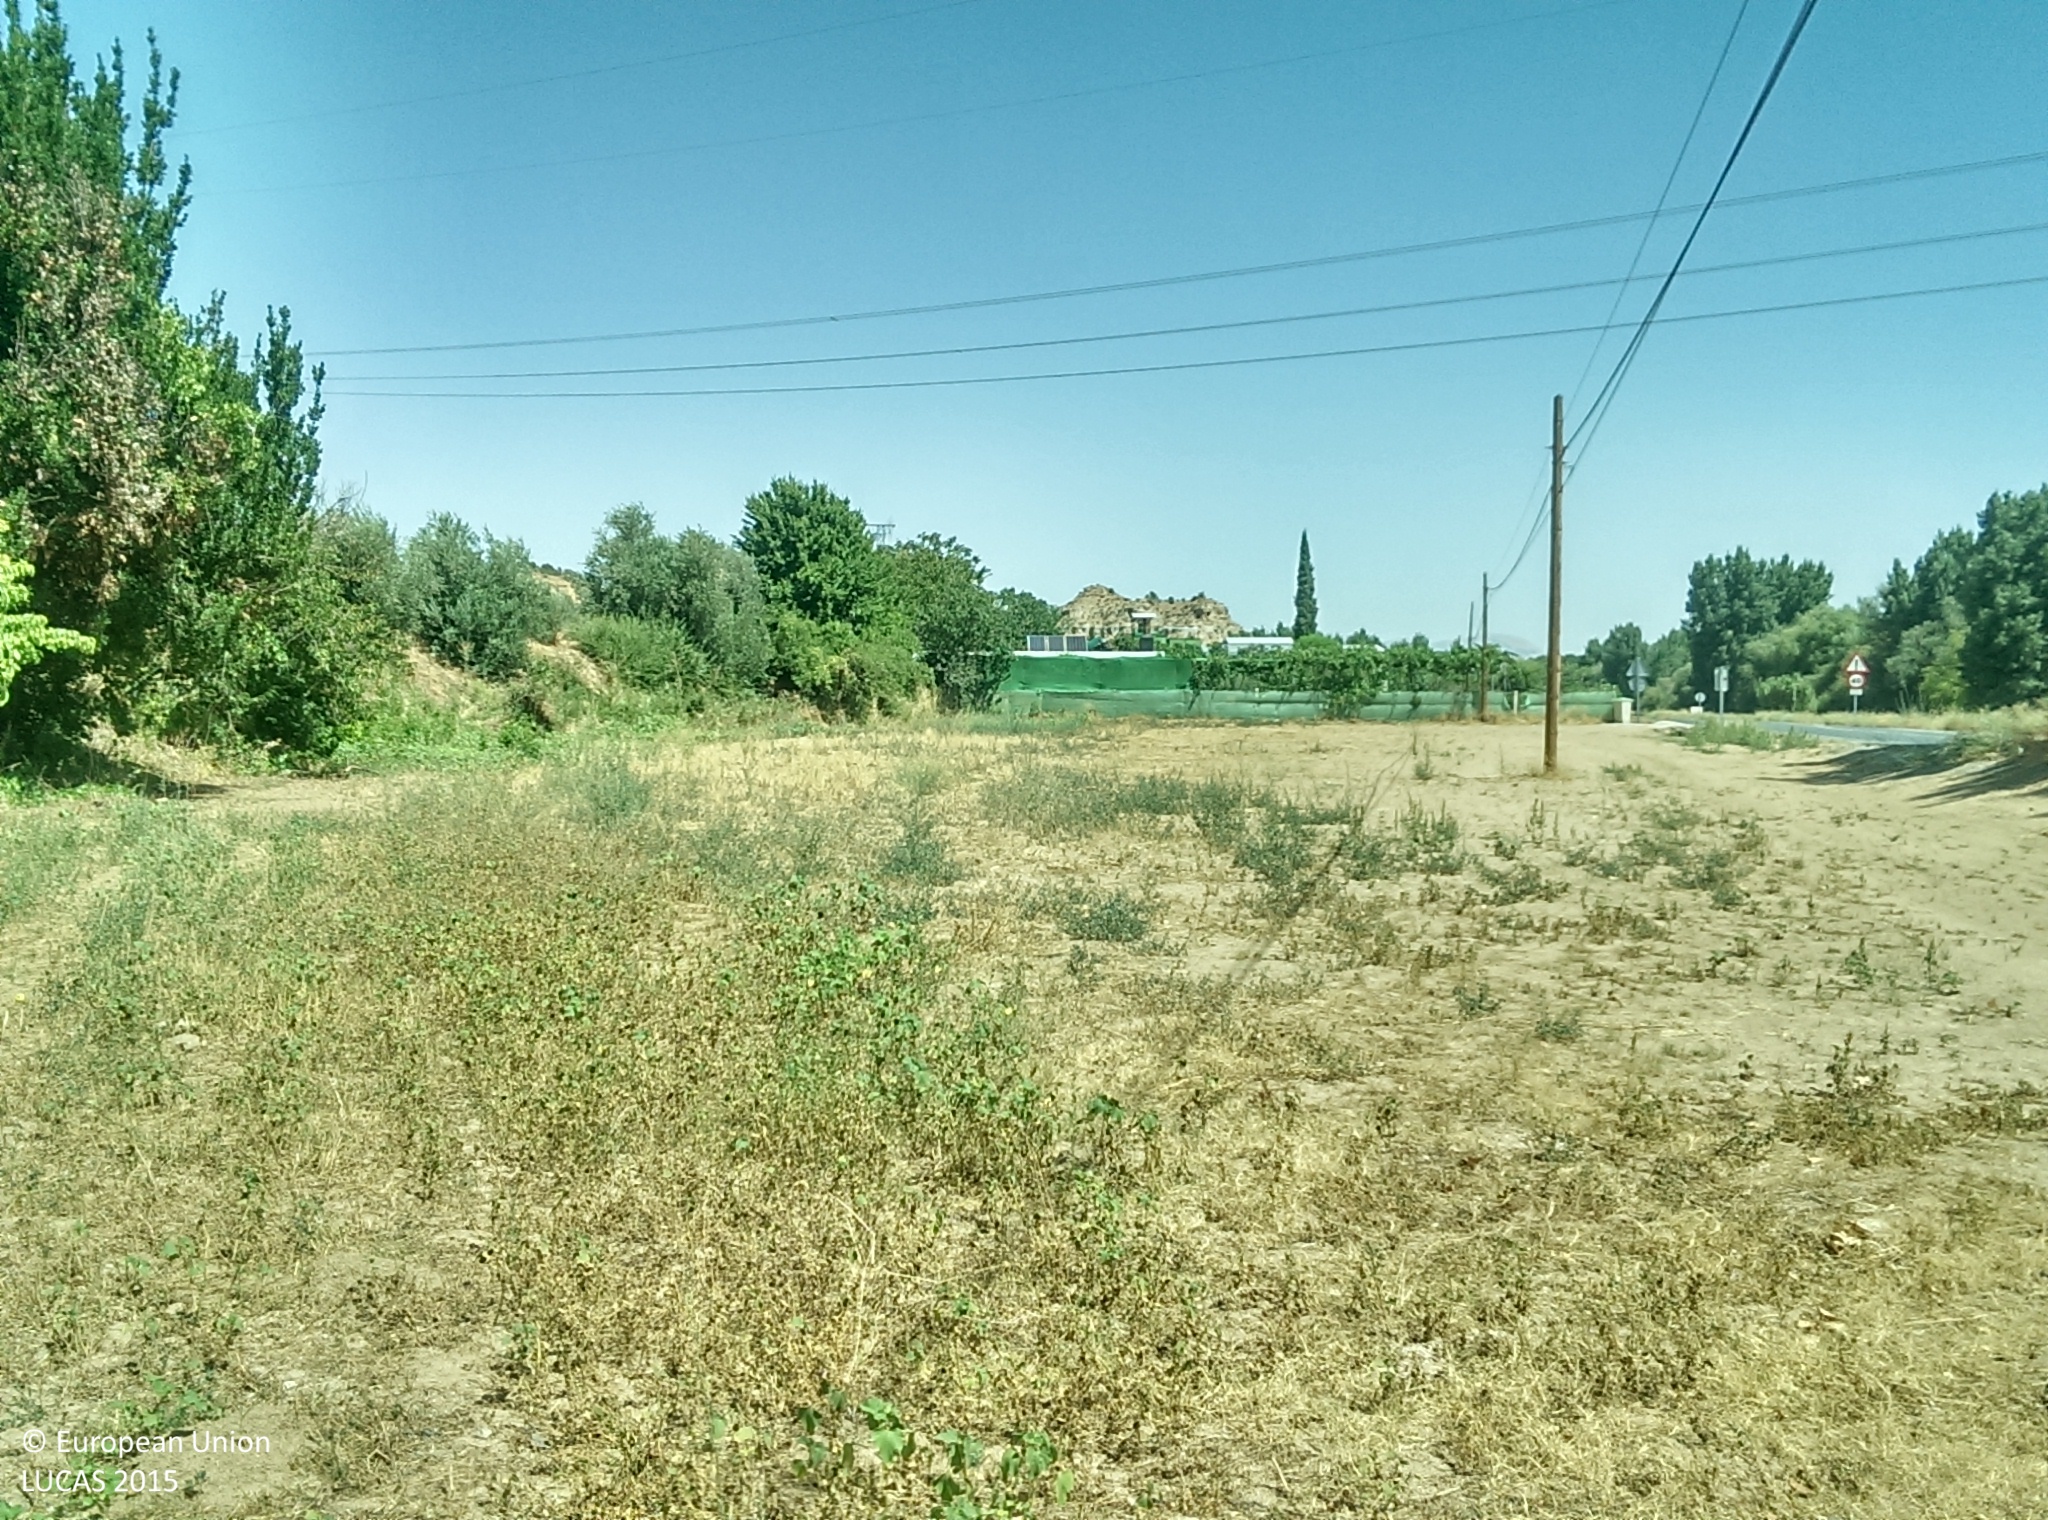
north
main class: Grassland
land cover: Spontaneously vegetated surfaces
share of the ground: 50 - 75 %
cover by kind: herbaceous plants 60 %, unconsolidated bare surface 40 %
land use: Fallow land
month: July
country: ES
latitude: 37.3004
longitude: -3.1983
